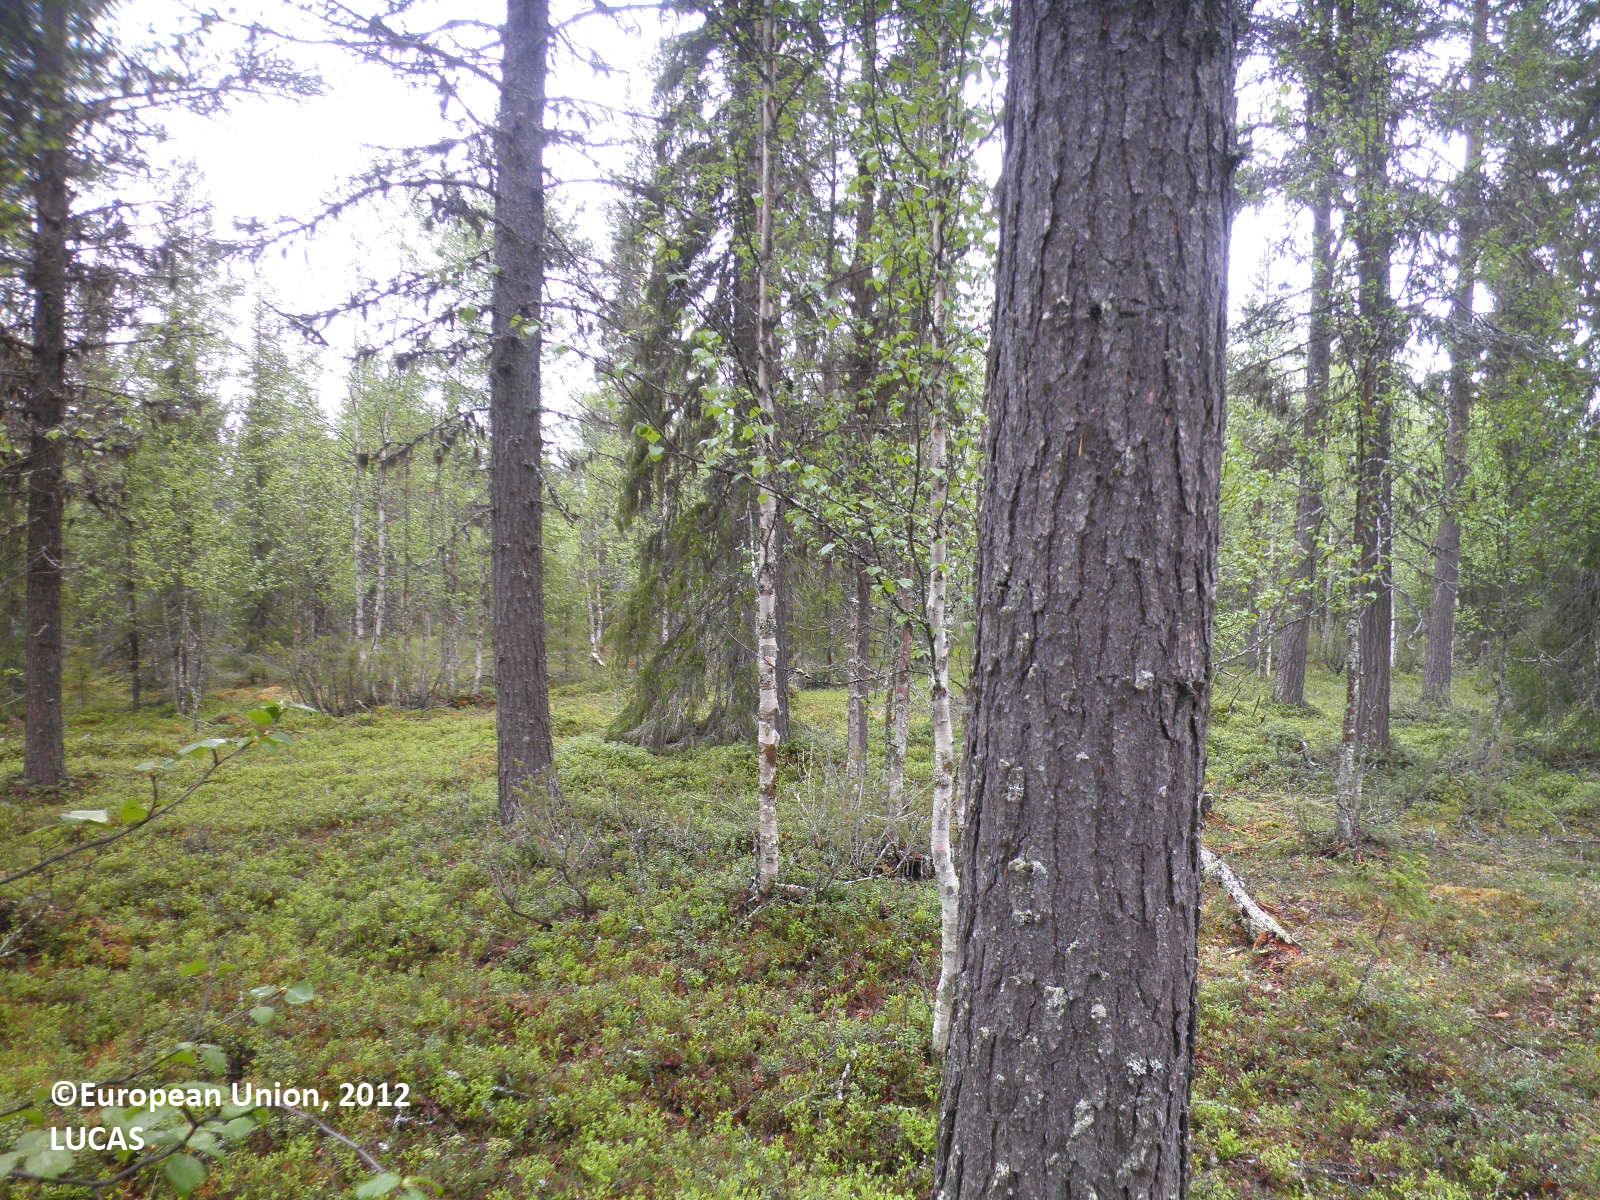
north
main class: Woodland
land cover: Pine dominated mixed woodland
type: boreal forest
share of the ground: > 75 %
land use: Forestry
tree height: > 5 m
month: June
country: FI
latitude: 68.0839
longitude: 25.4274
